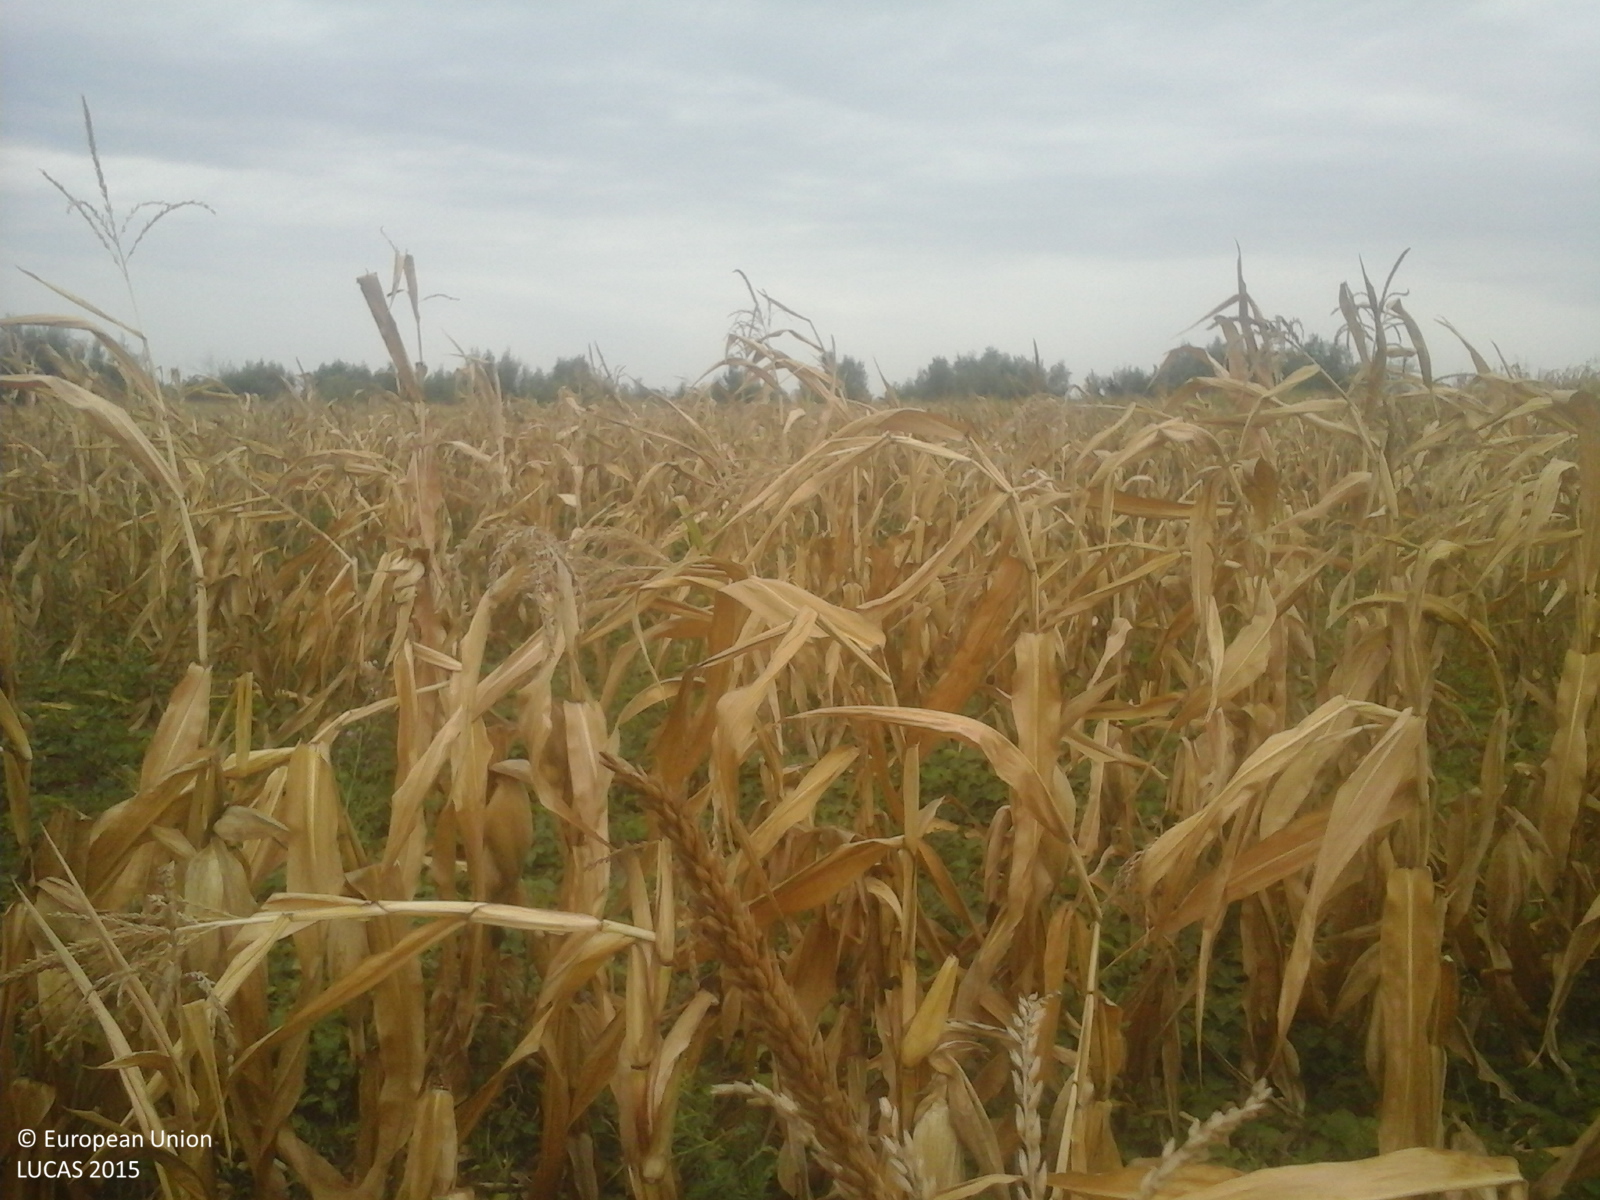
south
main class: Cropland
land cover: Maize
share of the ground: > 75 %
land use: Agriculture (excluding fallow land and kitchen gardens)
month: September
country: RO
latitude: 47.6323
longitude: 22.6905
